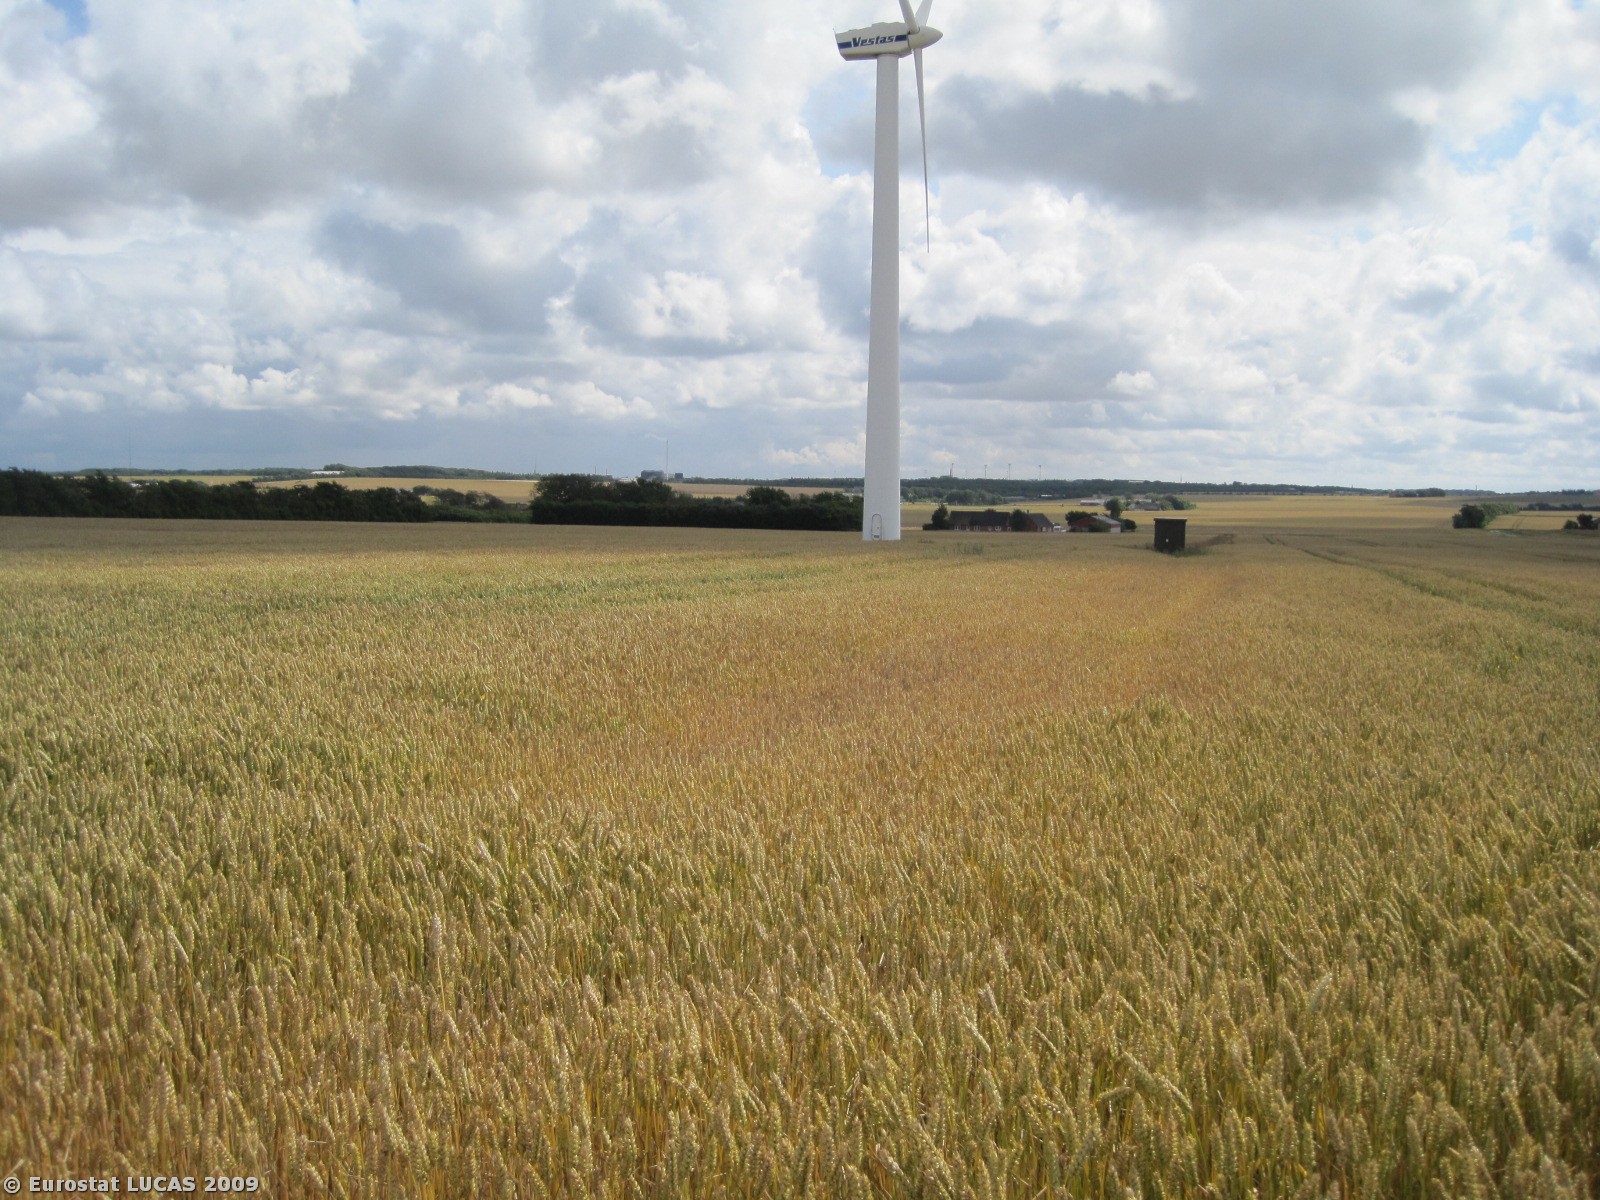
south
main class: Cropland
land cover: Common wheat
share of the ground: > 75 %
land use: Agriculture (excluding fallow land and kitchen gardens)
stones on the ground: 25 - 50 %
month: July
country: DK
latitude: 56.9903
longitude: 8.7017
